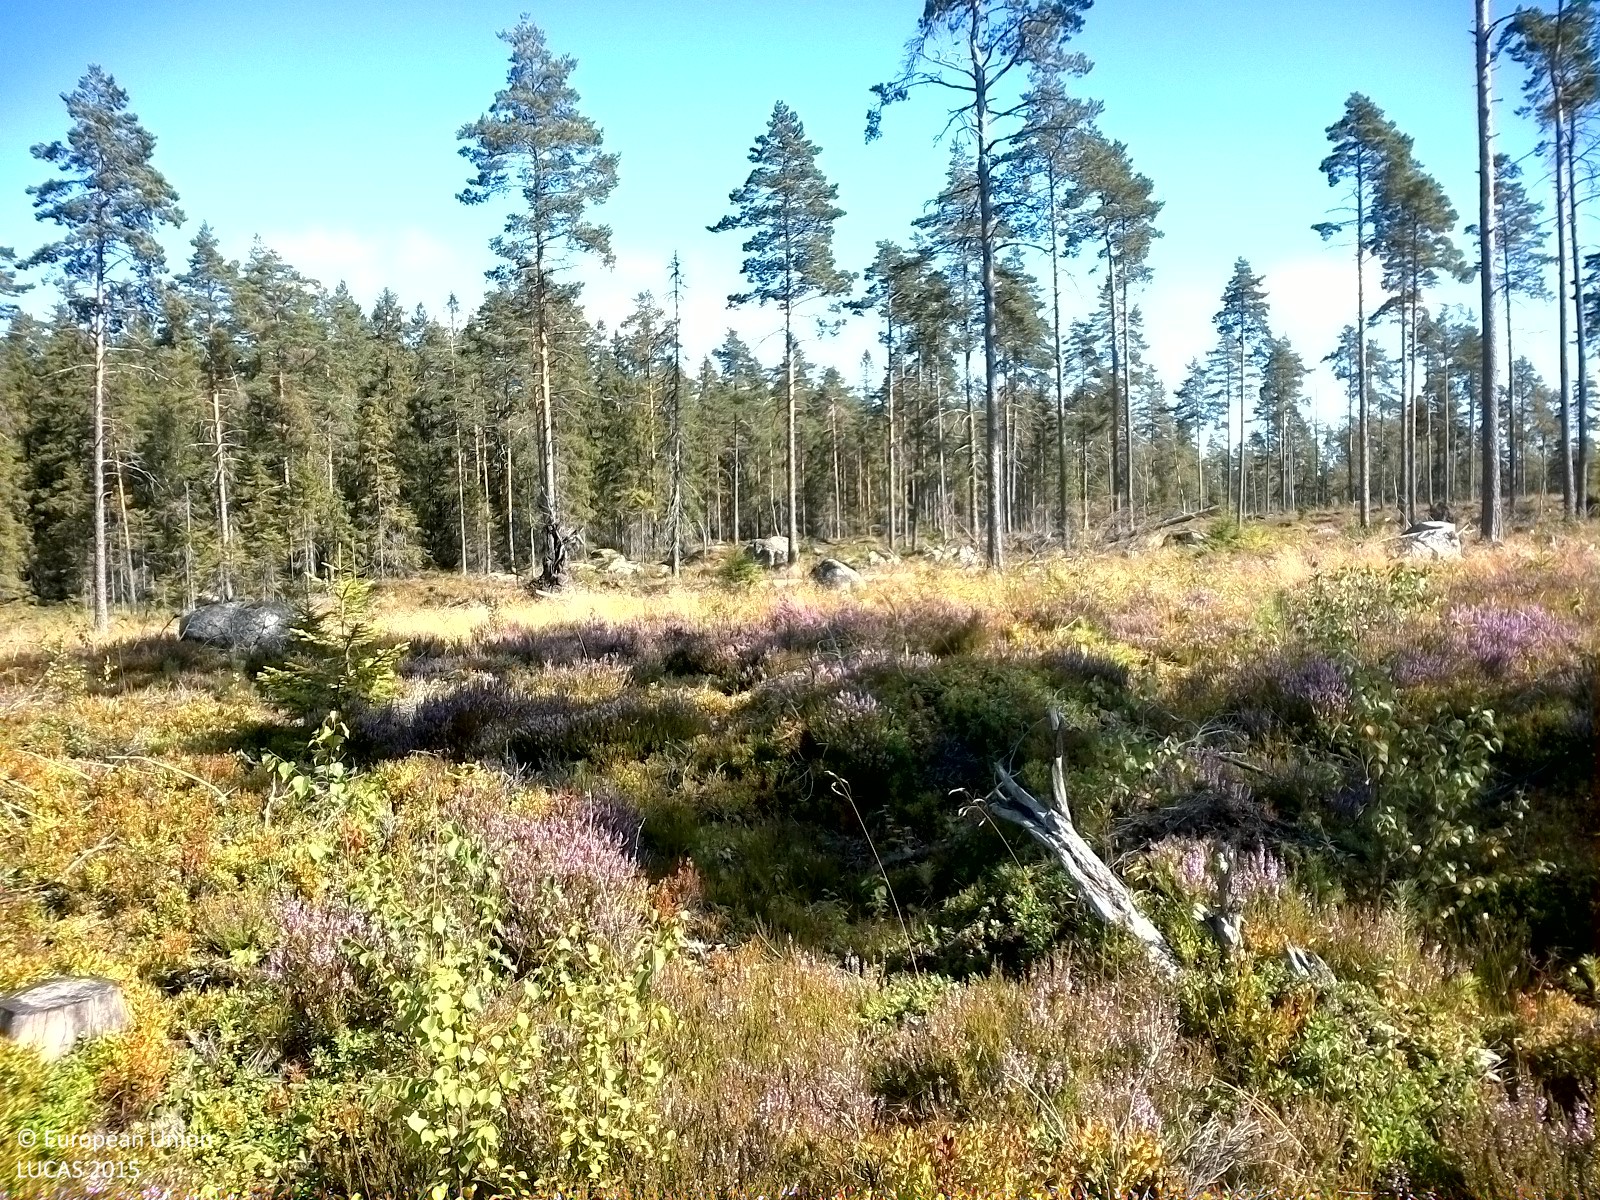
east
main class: Woodland
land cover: Pine dominated coniferous woodland
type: boreal forest
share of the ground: 10 - 25 %
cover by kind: shrubs 45 %, herbaceous plants 25 %, coniferous forest trees 15 %, lichens and mosses 15 %
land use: Forestry
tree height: > 5 m
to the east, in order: Pine dominated coniferous woodland; Tracks; Pine dominated coniferous woodland; Tracks; Pine dominated coniferous woodland; Tracks; Pine dominated coniferous woodland
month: August
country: SE
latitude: 59.4173
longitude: 14.6960
